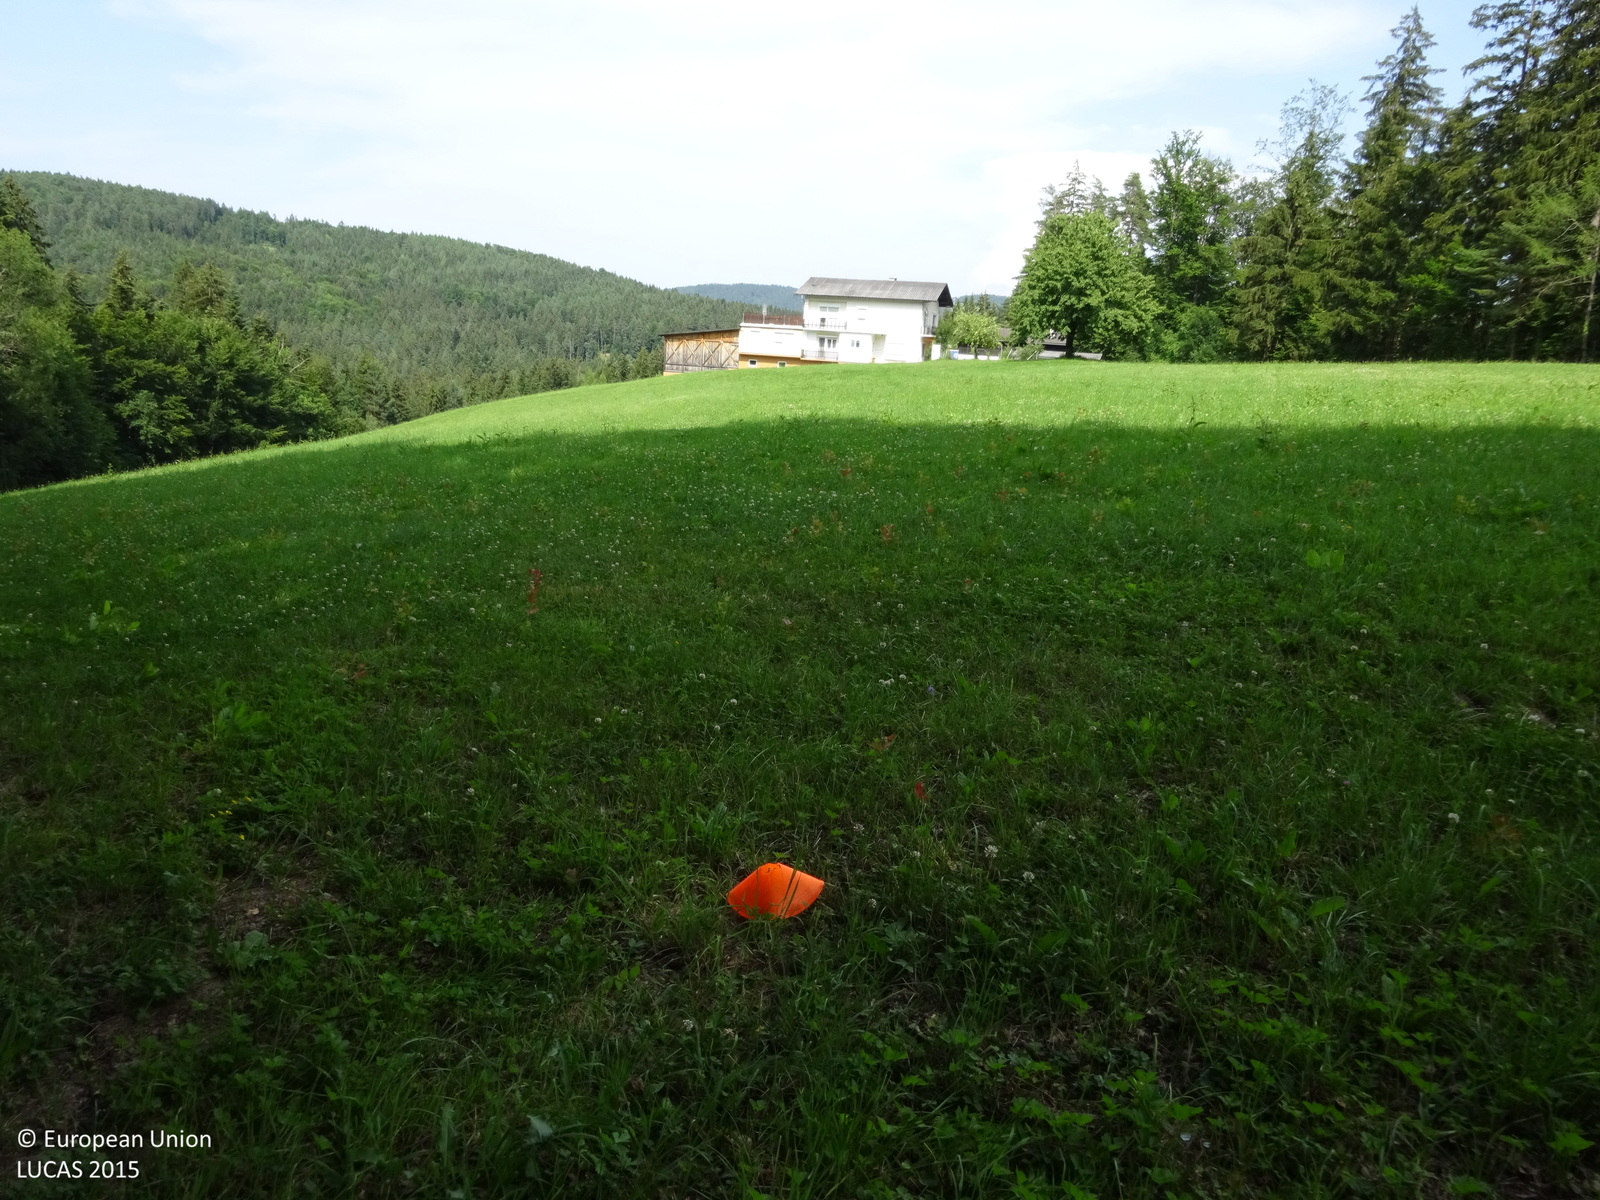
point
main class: Grassland
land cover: Grassland without tree/shrub cover
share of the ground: > 75 %
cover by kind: herbaceous plants 100 %
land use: Agriculture (excluding fallow land and kitchen gardens)
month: July
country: AT
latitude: 47.0740
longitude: 15.1749
